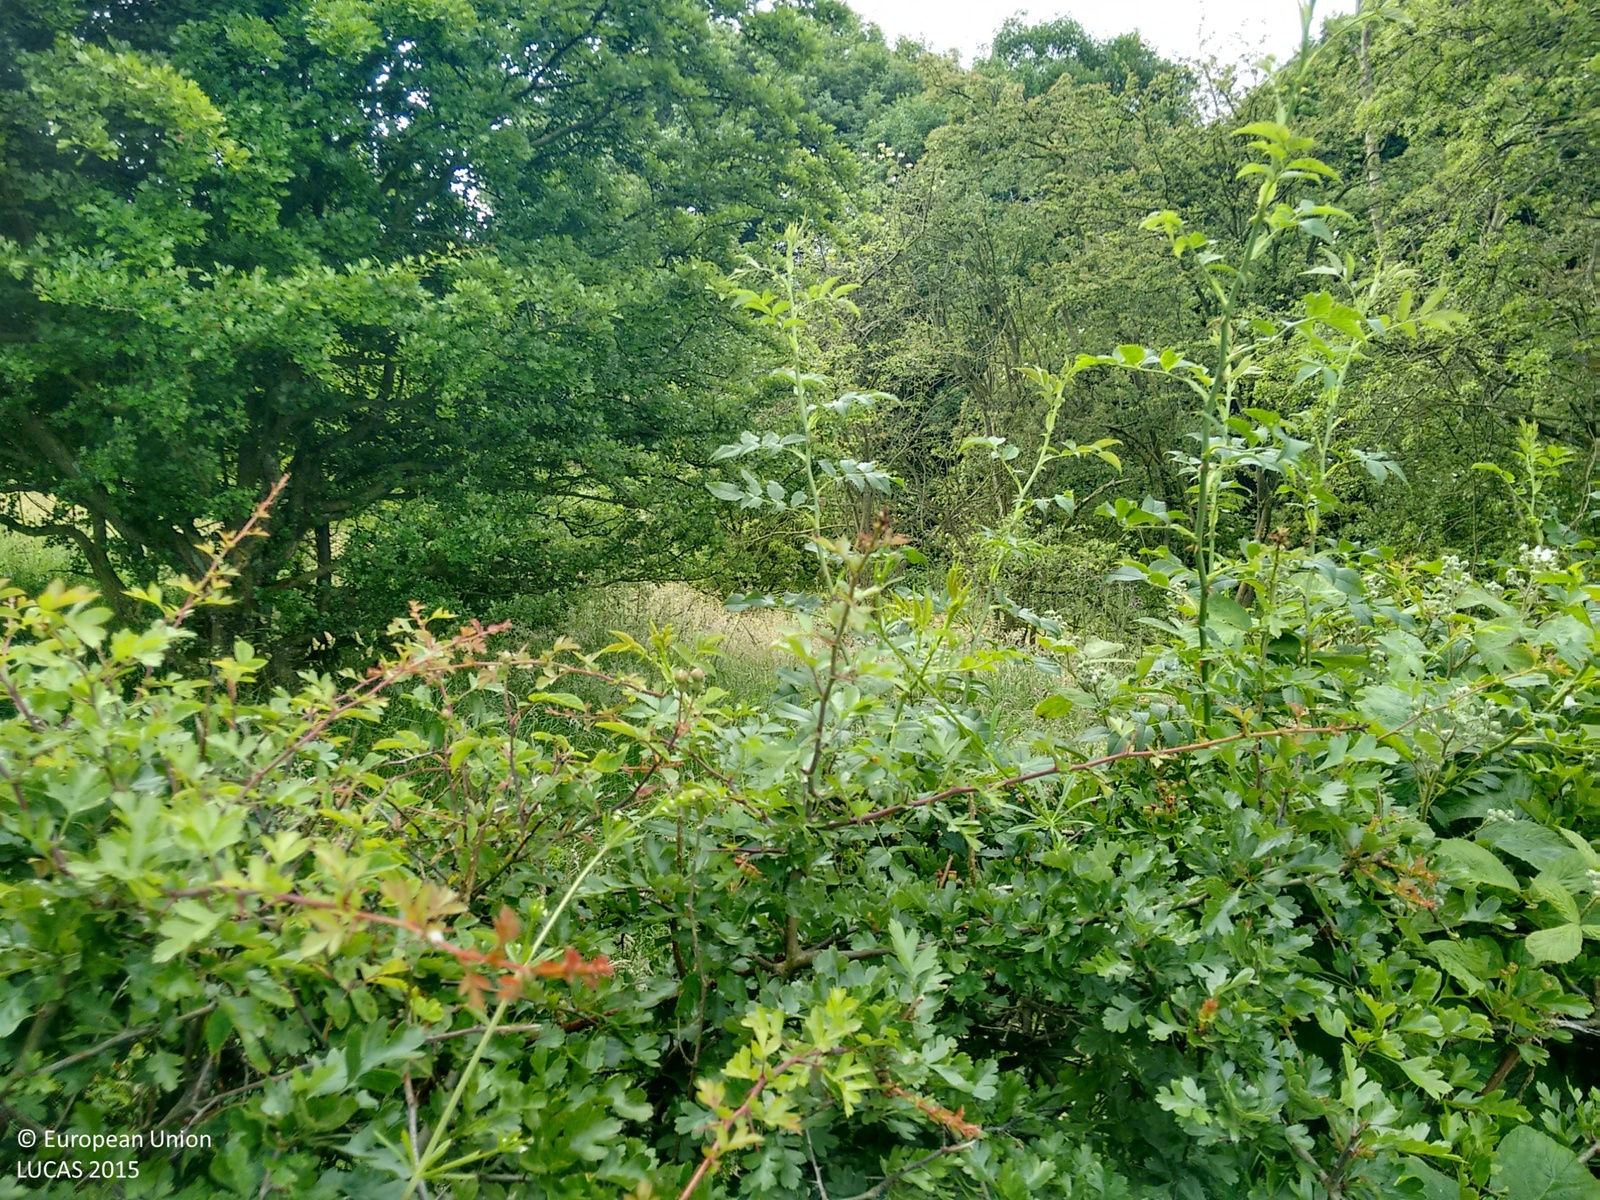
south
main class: Grassland
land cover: Grassland with sparse tree/shrub cover
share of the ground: > 75 %
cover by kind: herbaceous plants 85 %, shrubs 10 %, broadleaved forest trees 5 %
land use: Agriculture (excluding fallow land and kitchen gardens)
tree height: > 5 m
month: June
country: GB
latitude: 53.3032
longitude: -1.5303
